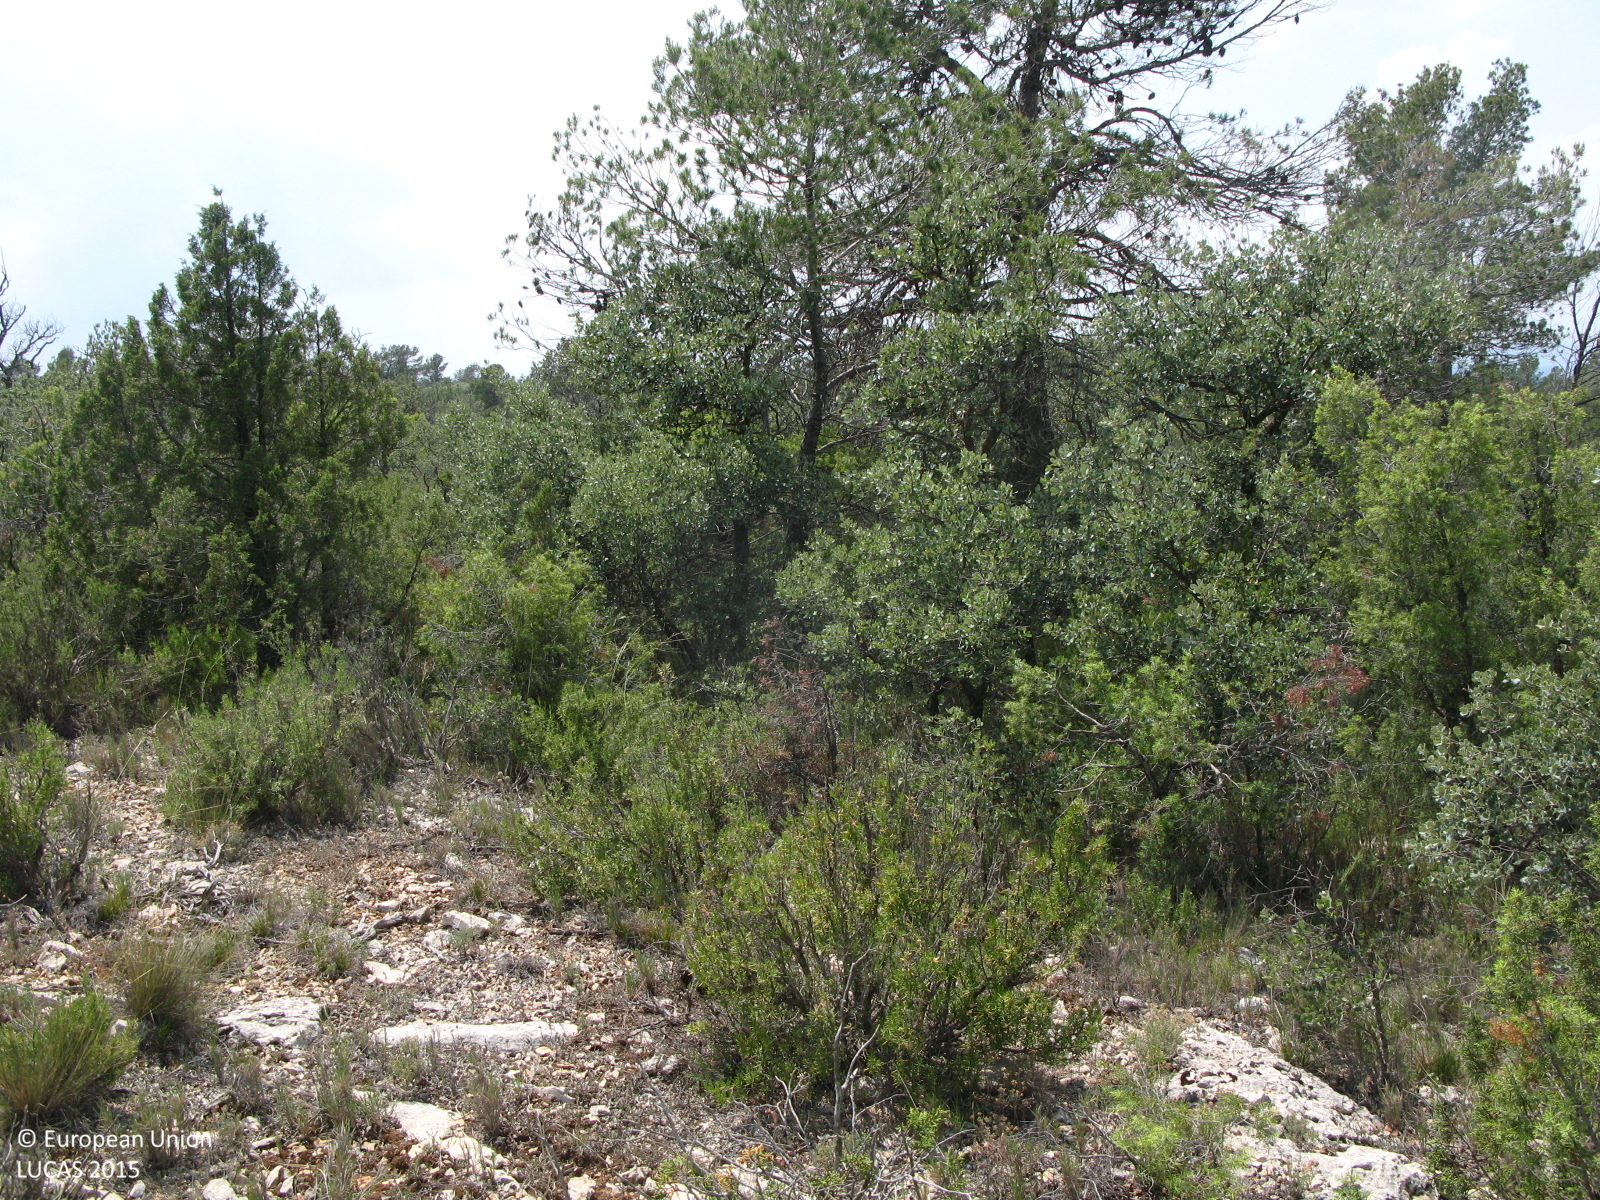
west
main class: Woodland
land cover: Broadleaved woodland
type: broadleaved evergreen forest
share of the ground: 10 - 25 %
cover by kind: broadleaved forest trees 35 %, shrubs 35 %, consolidated bare surface 15 %, herbaceous plants 10 %, coniferous forest trees 5 %
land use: Forestry
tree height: < 5 m
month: June
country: ES
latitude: 39.7962
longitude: -0.9701
